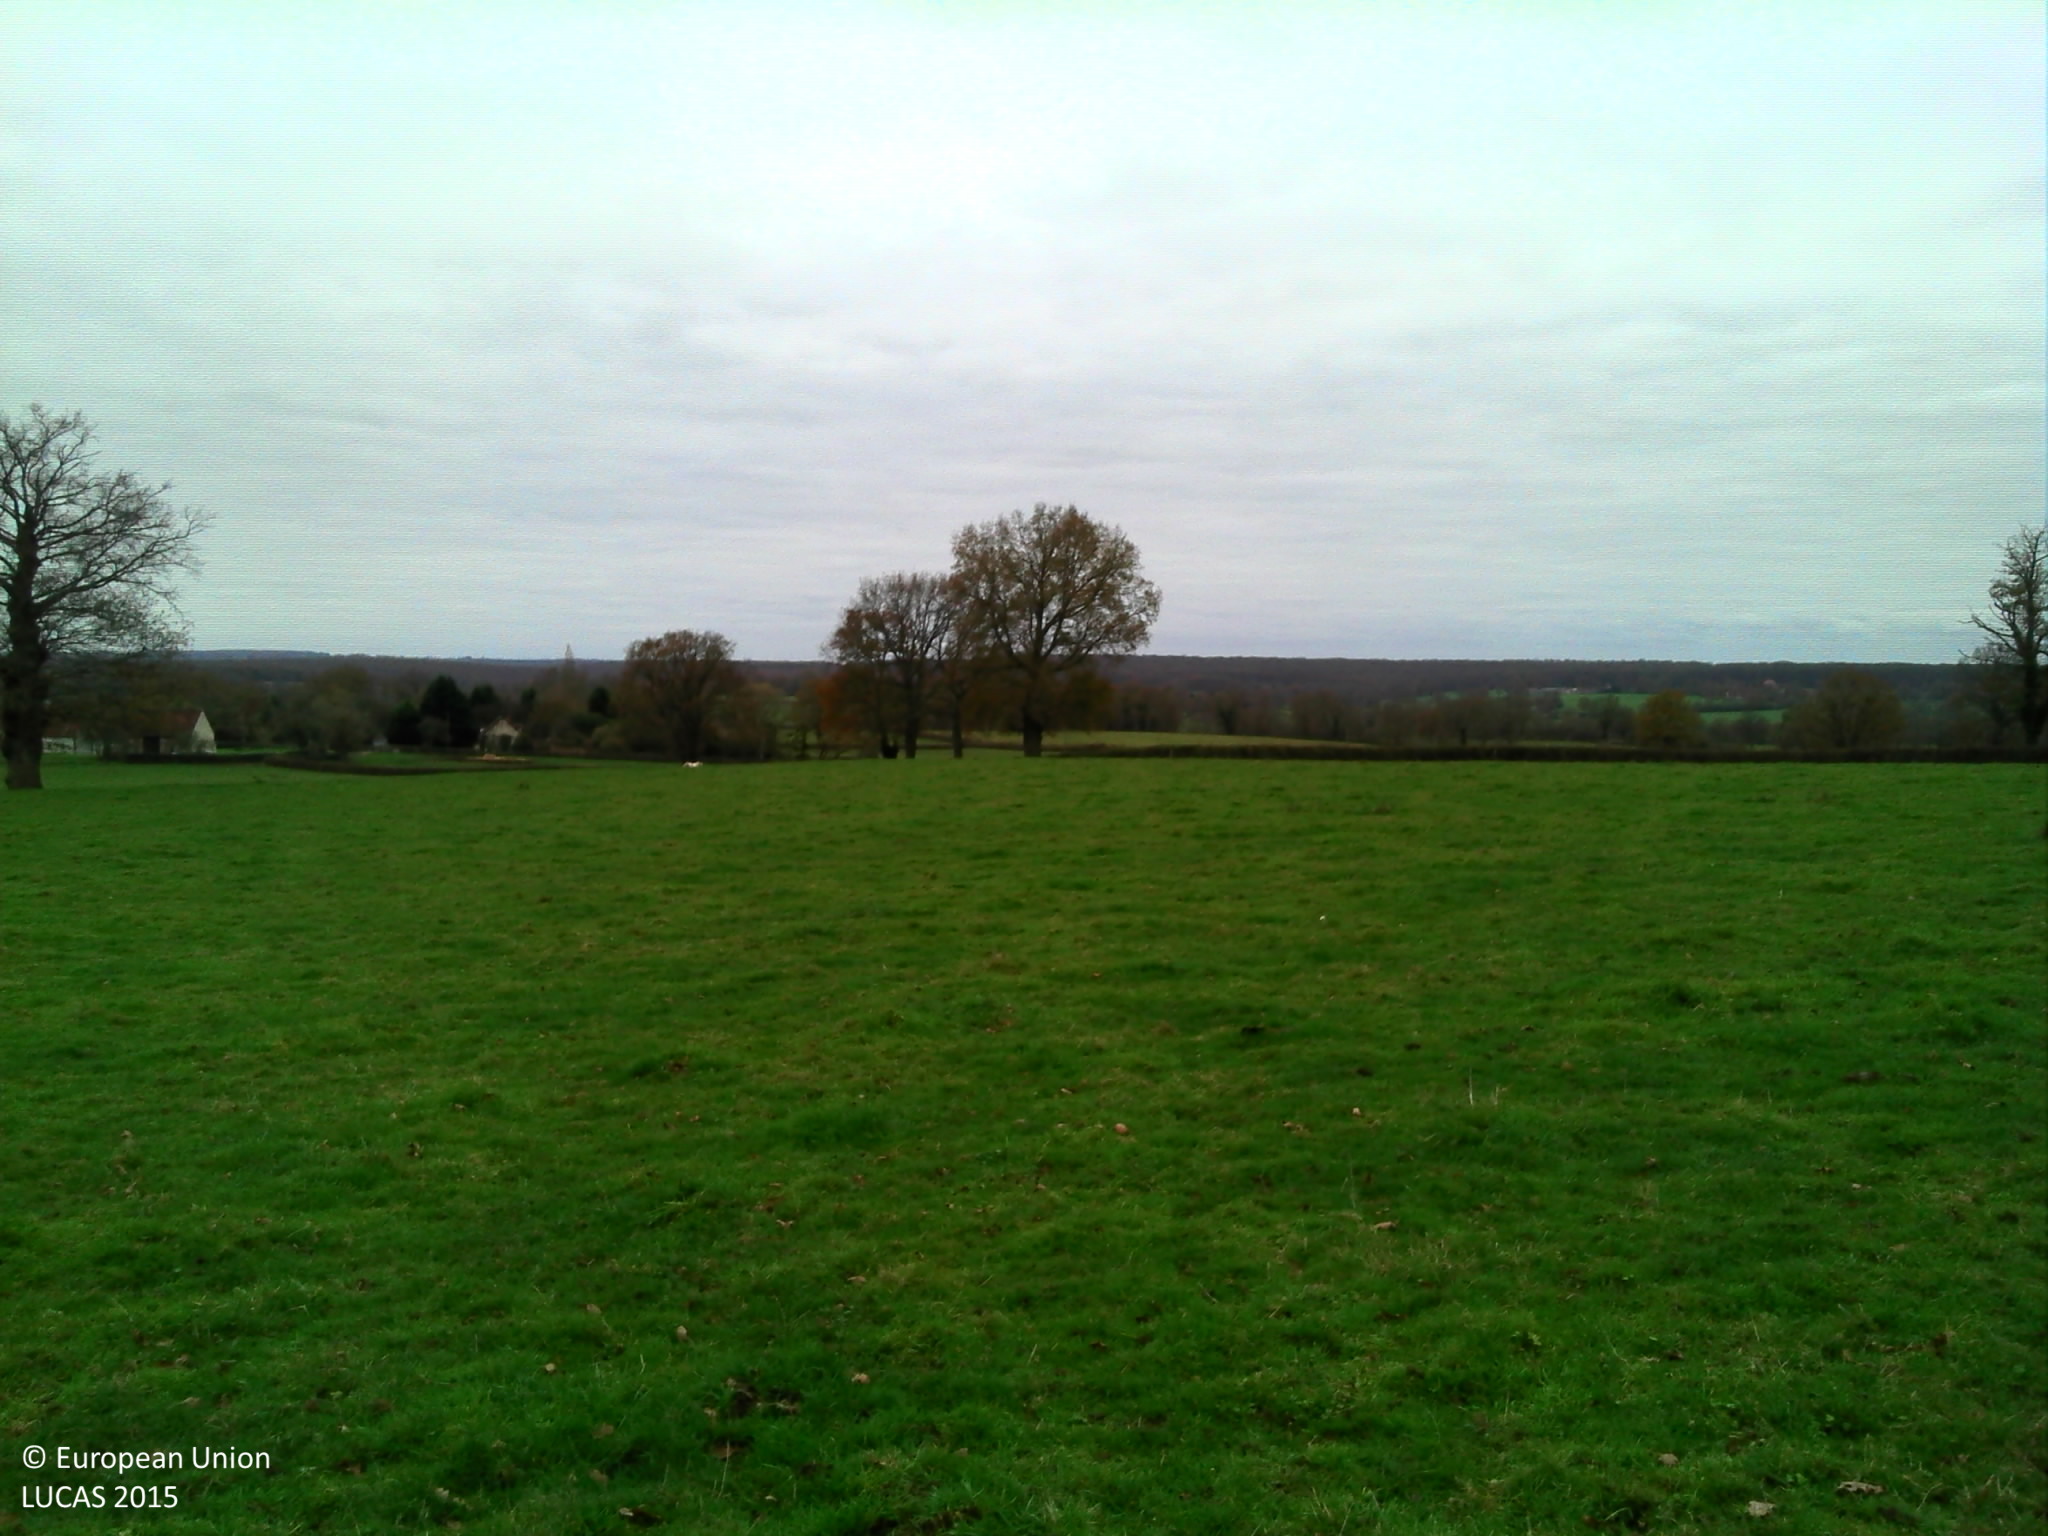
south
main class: Grassland
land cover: Grassland without tree/shrub cover
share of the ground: > 75 %
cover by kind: herbaceous plants 100 %
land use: Agriculture (excluding fallow land and kitchen gardens)
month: July
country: FR
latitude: 46.5355
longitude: 2.9690
